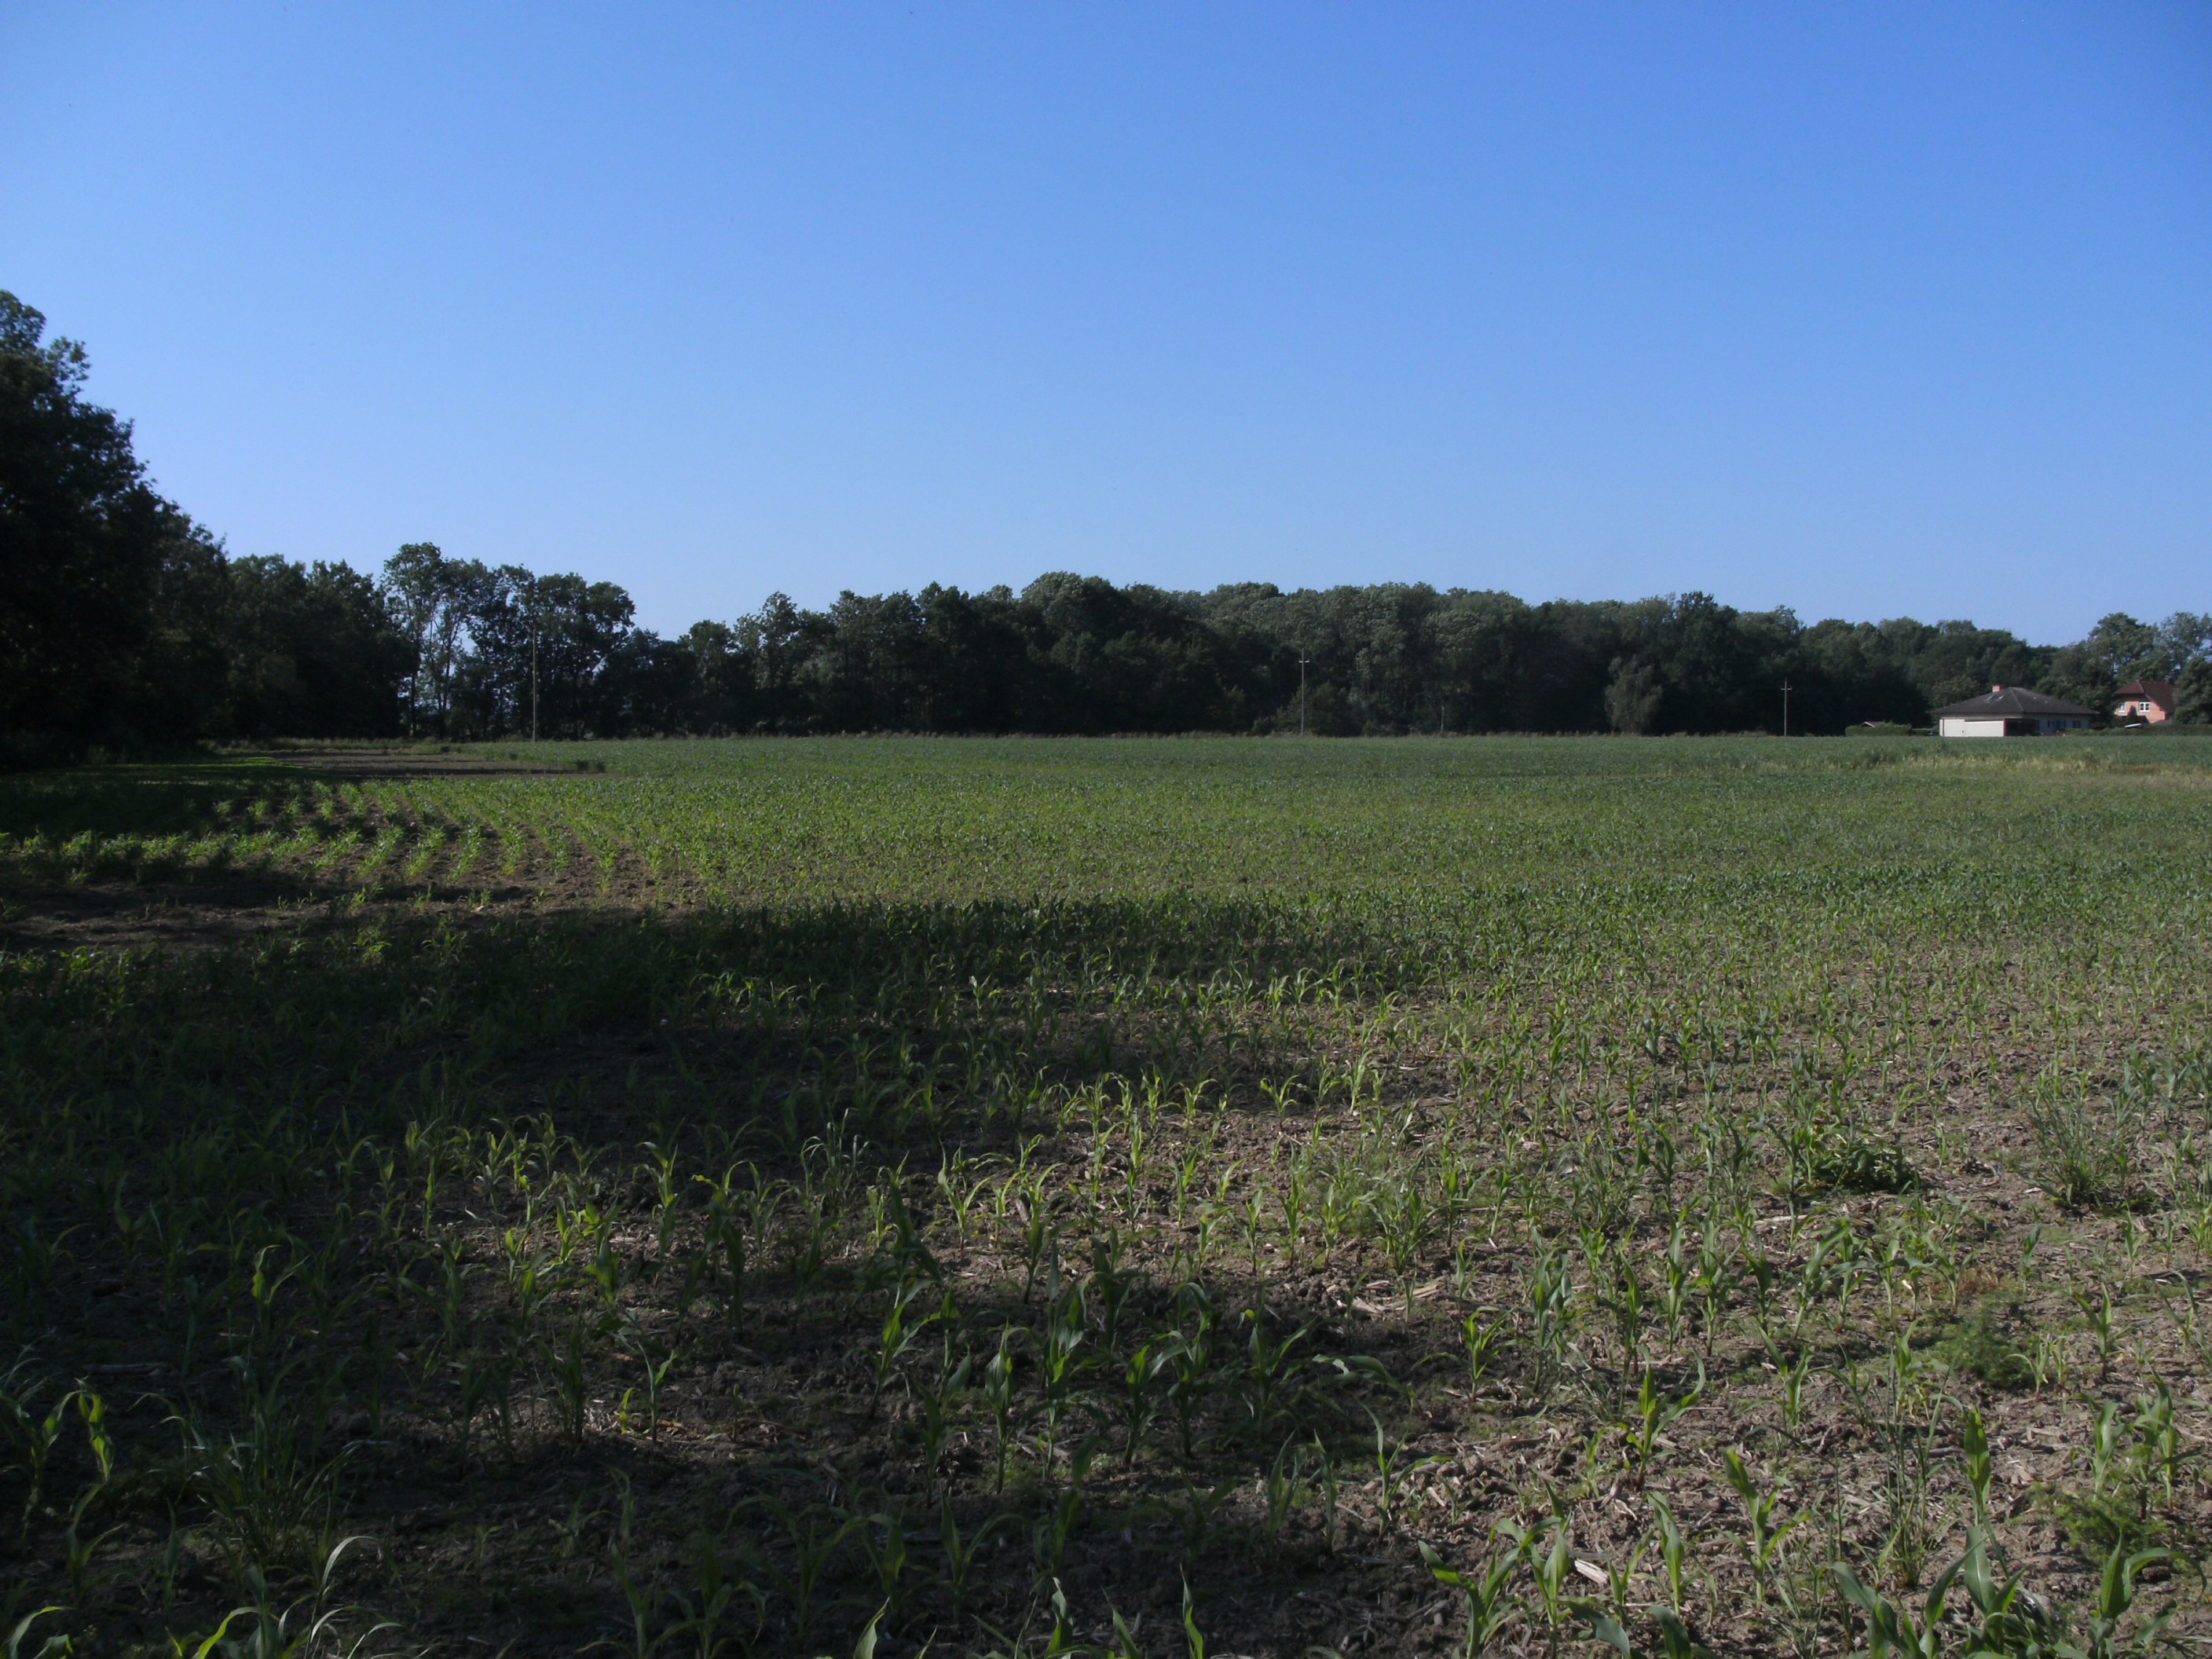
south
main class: Cropland
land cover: Maize
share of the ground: 25 - 50 %
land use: Agriculture (excluding fallow land and kitchen gardens)
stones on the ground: < 10 %
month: June
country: AT
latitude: 48.2032
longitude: 14.0498
